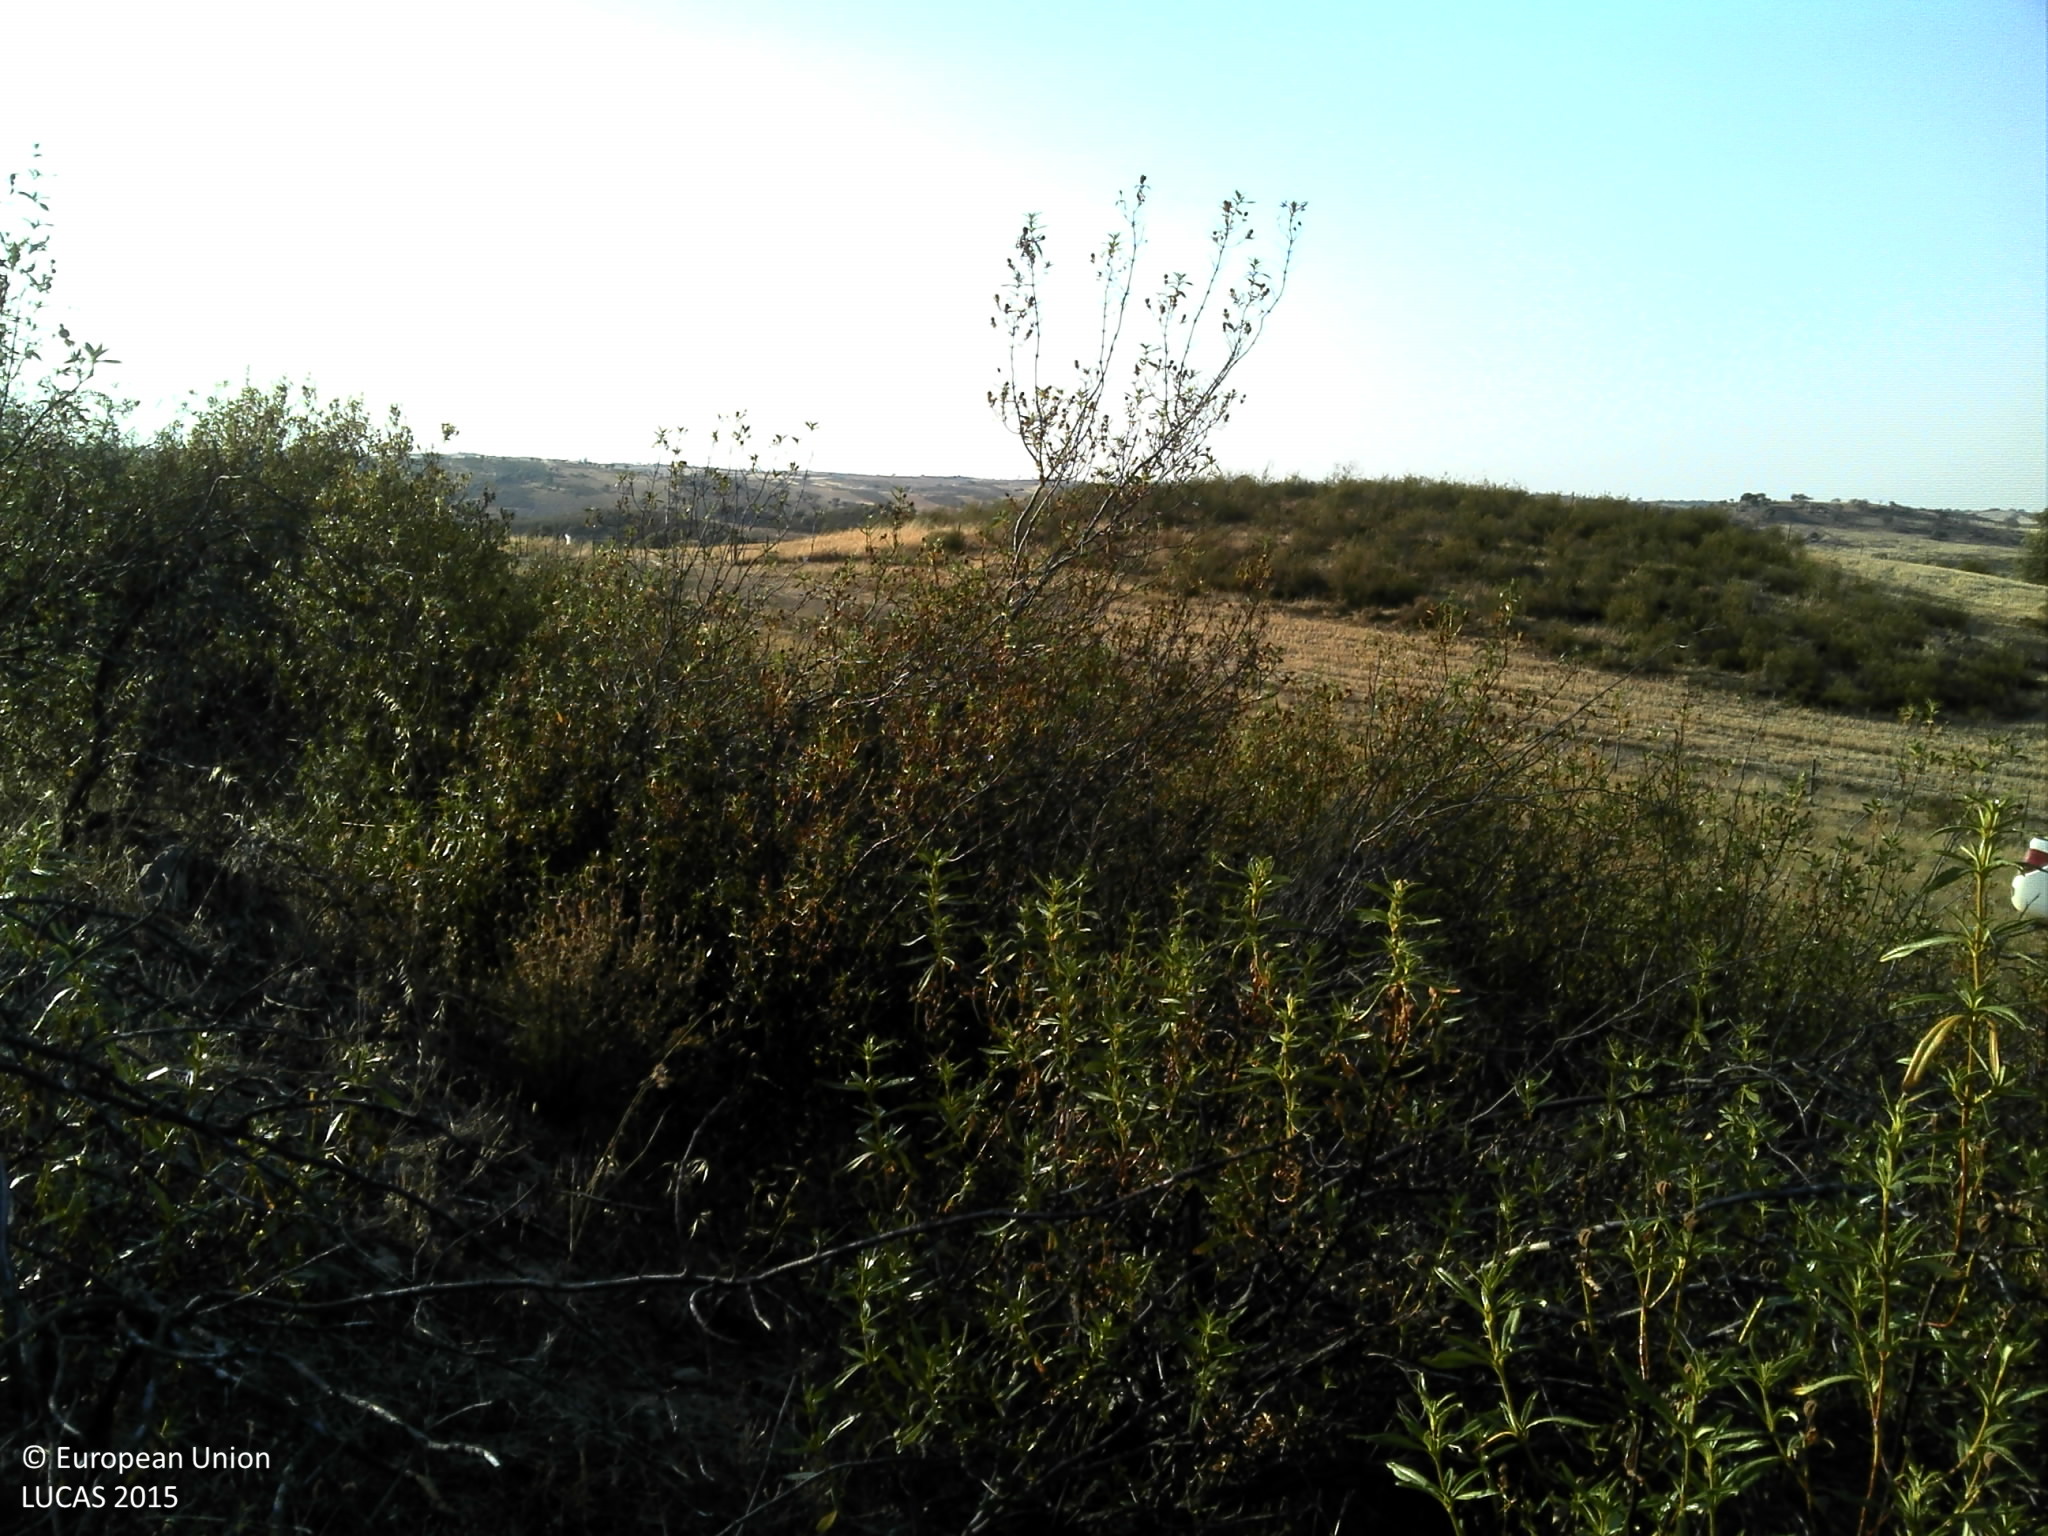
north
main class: Shrubland
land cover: Shrubland without tree cover
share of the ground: > 75 %
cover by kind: shrubs 100 %
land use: Agriculture (excluding fallow land and kitchen gardens)
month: June
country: PT
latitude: 37.5139
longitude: -7.9053
